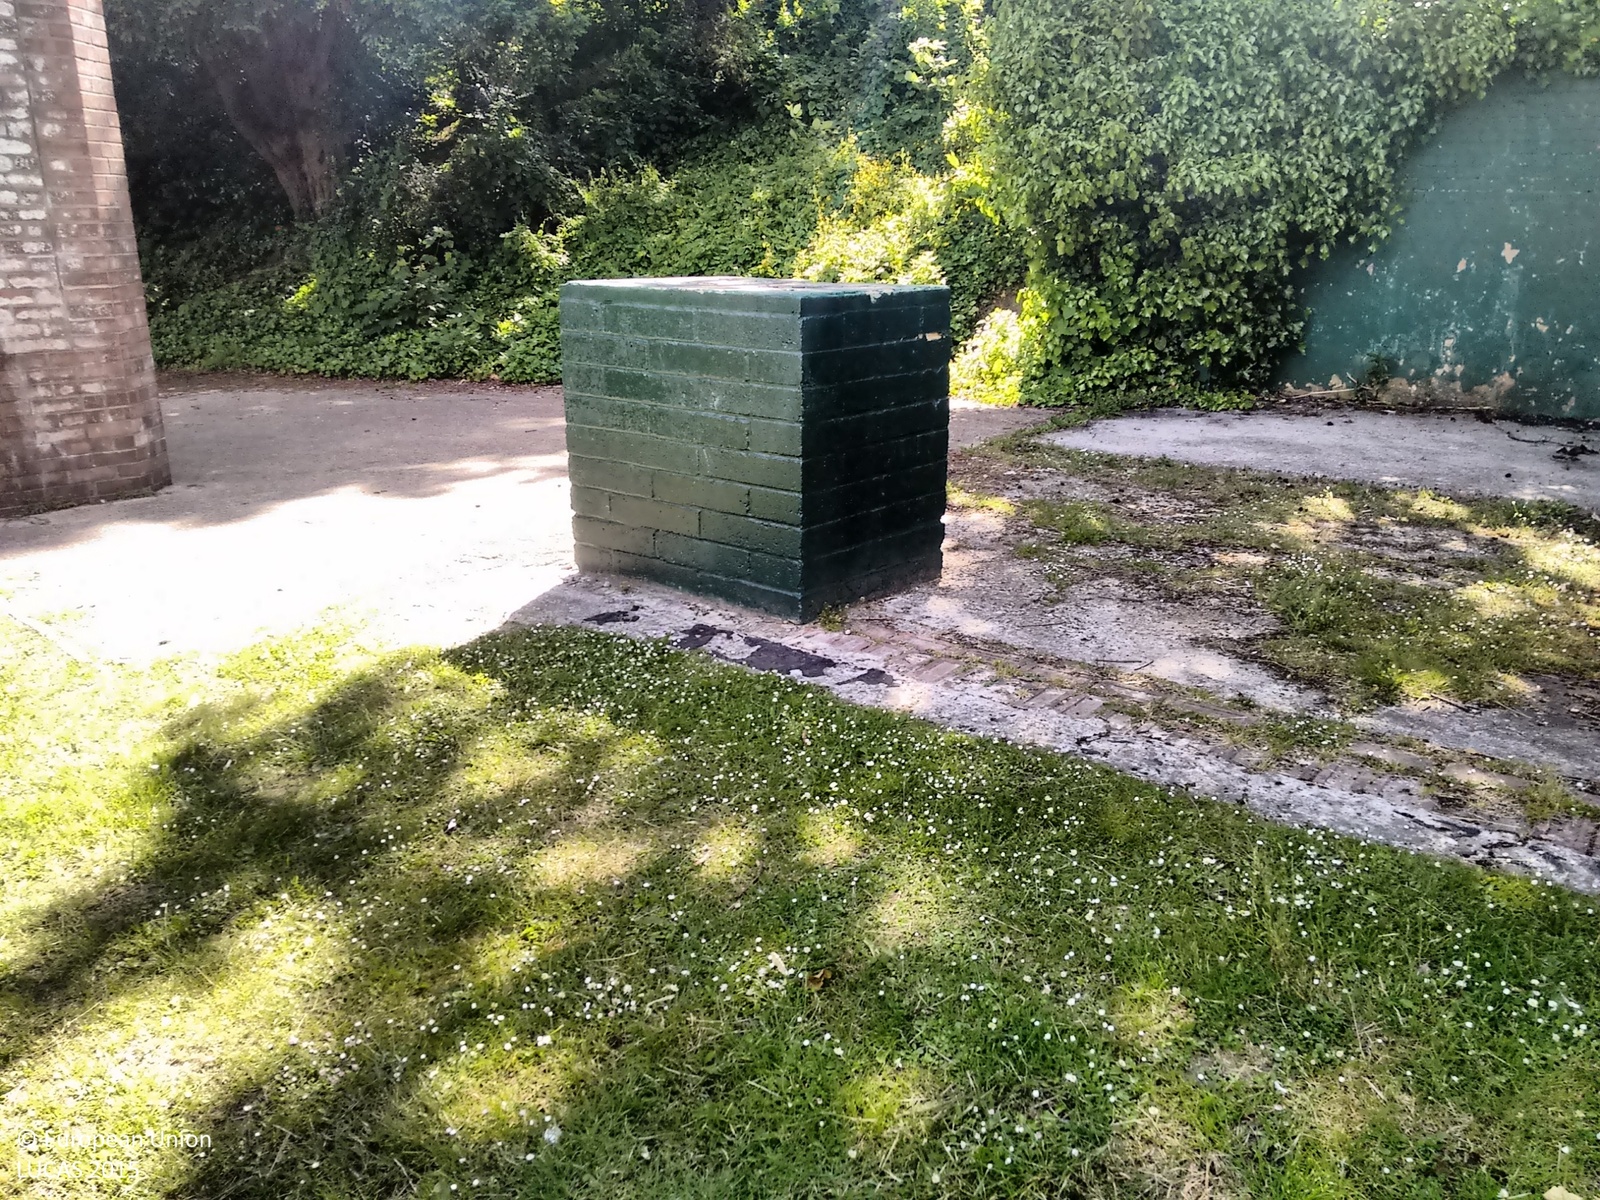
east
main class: Grassland
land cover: Grassland without tree/shrub cover
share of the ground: > 75 %
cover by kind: herbaceous plants 100 %
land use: Amenities, museums, leisure
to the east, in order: Grassland without tree/shrub cover; Shrubland with sparse tree cover; Artificial constructions in urban areas
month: June
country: GB
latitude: 50.8618
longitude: 0.5819
